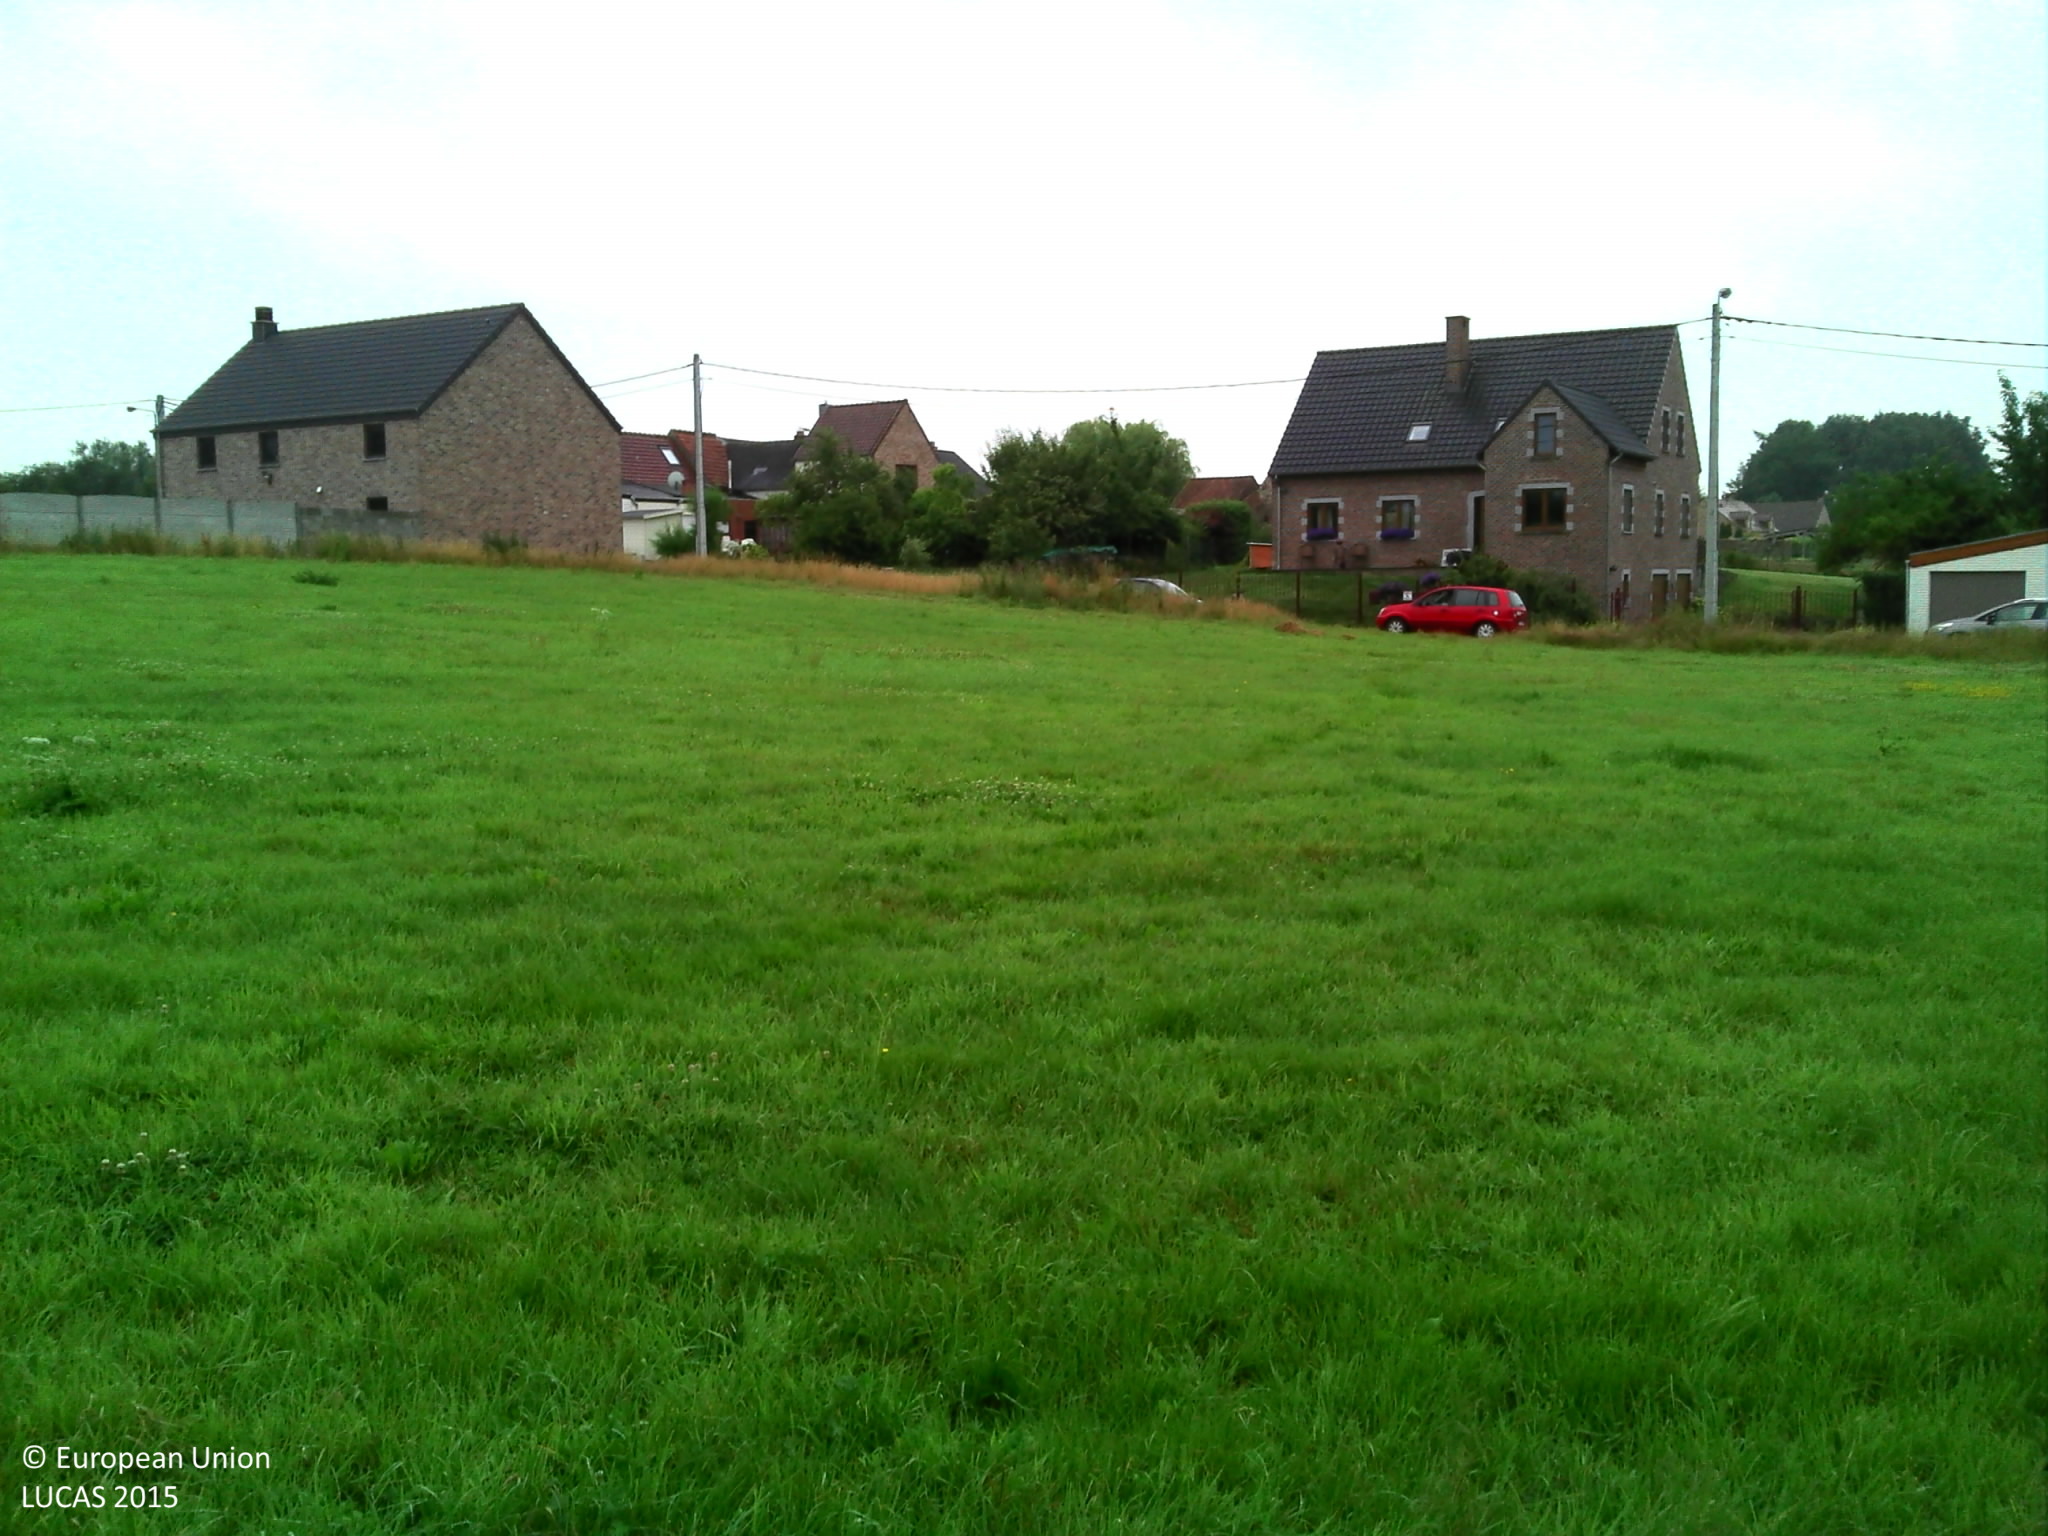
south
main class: Grassland
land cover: Grassland without tree/shrub cover
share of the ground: > 75 %
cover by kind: herbaceous plants 100 %
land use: Agriculture (excluding fallow land and kitchen gardens)
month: July
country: BE
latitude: 50.5818
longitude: 3.9353
